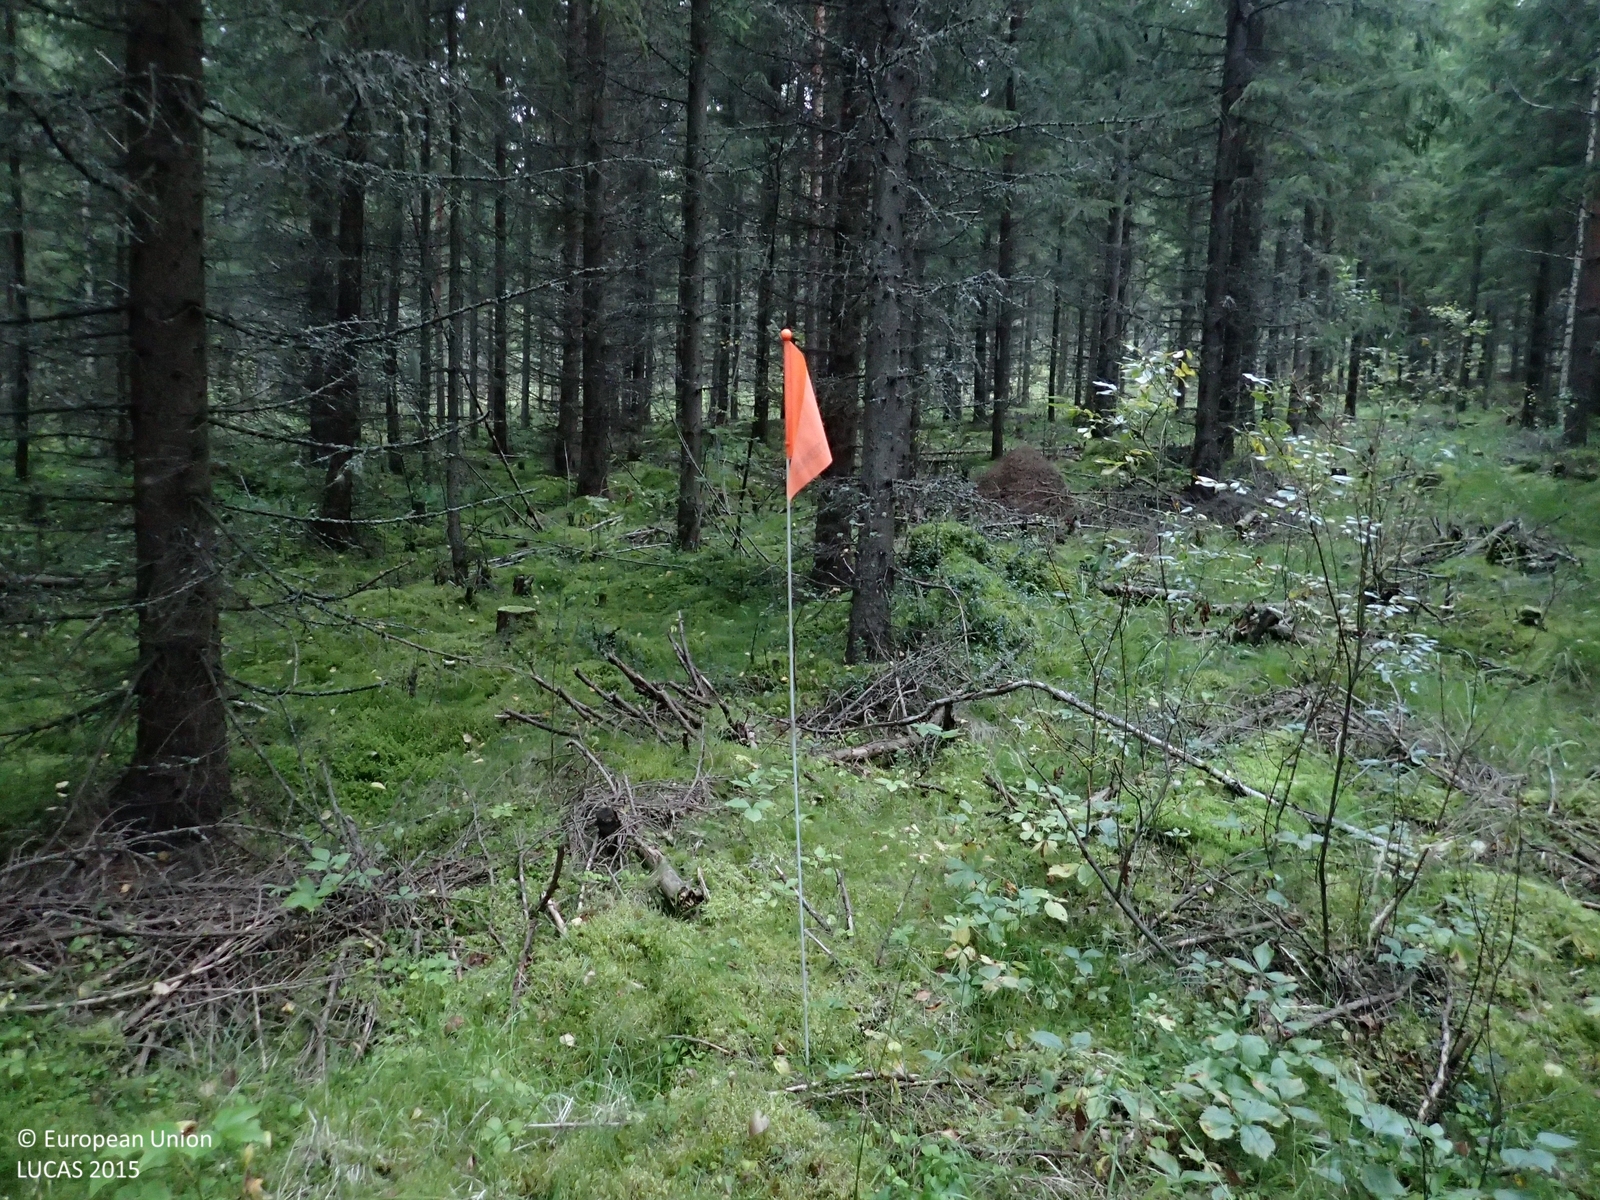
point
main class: Woodland
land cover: Spruce dominated coniferous woodland
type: boreal forest
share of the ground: > 75 %
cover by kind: coniferous forest trees 75 %, lichens and mosses 10 %, broadleaved forest trees 5 %, shrubs 5 %, herbaceous plants 5 %
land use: Forestry
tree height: > 5 m
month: September
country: FI
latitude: 63.0585
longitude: 25.8421
